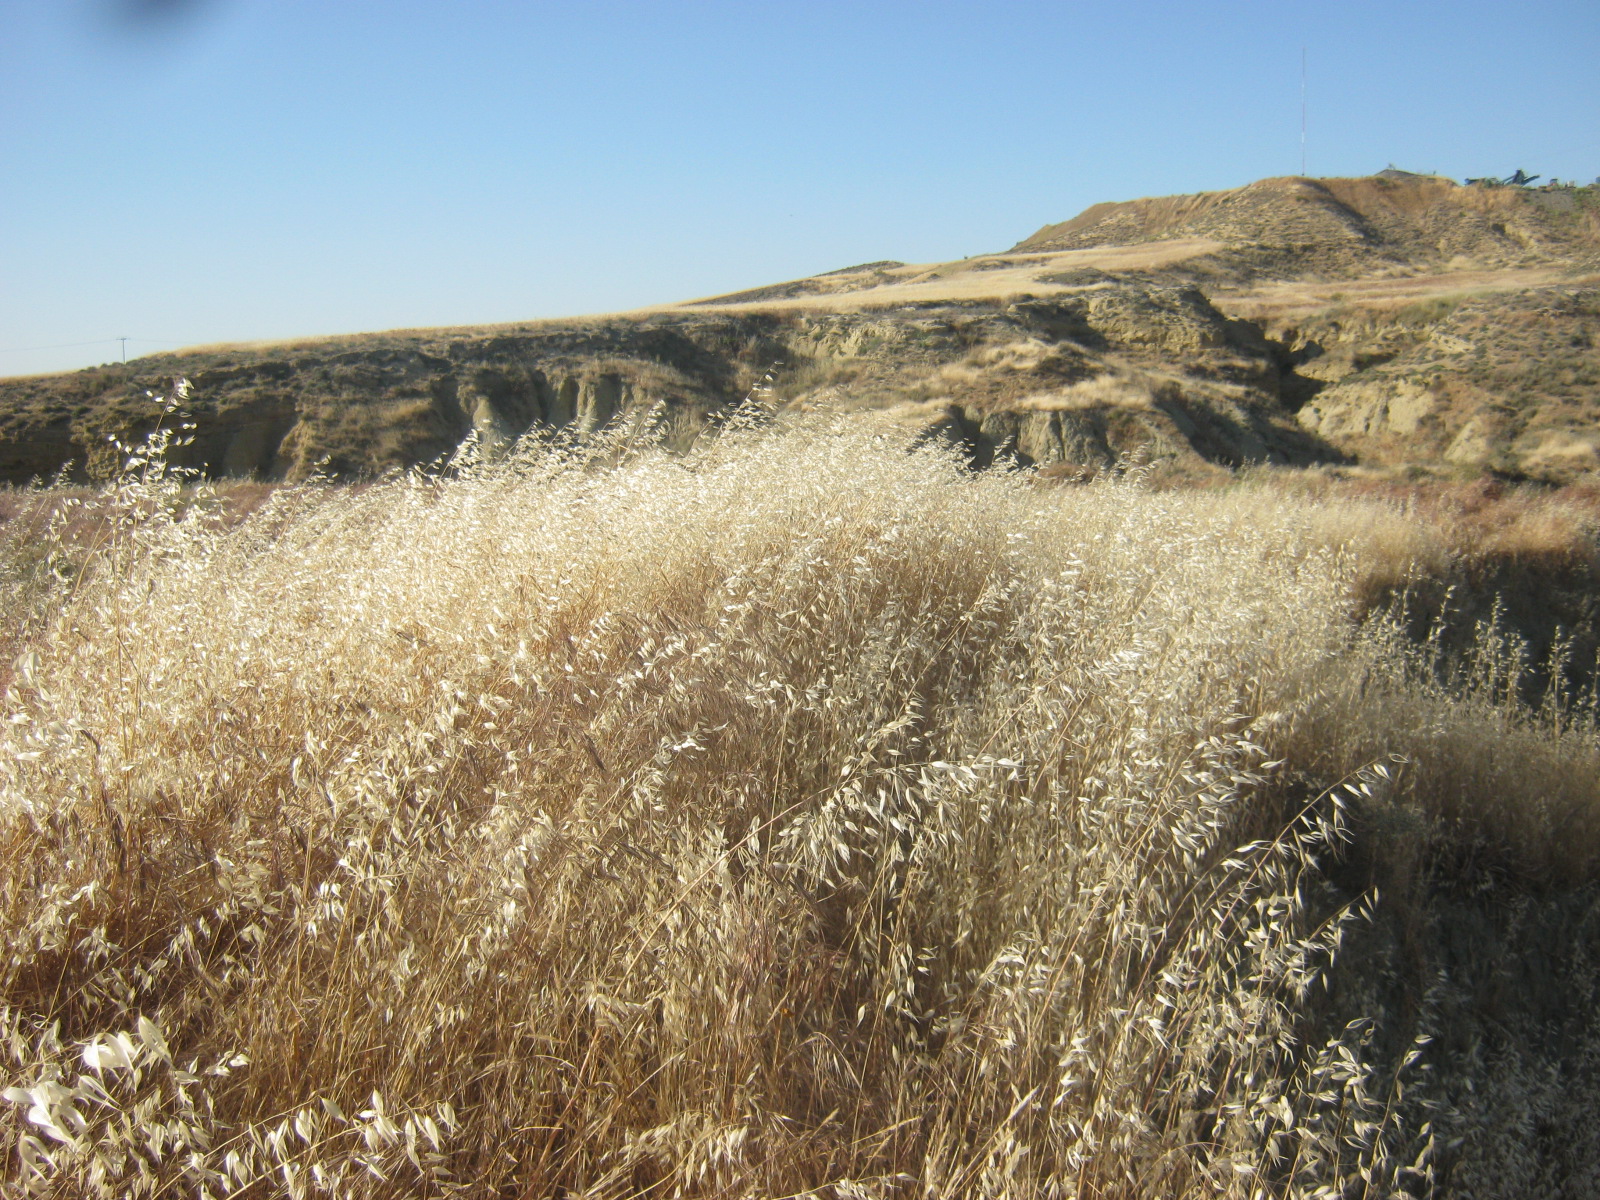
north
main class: Grassland
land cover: Spontaneously vegetated surfaces
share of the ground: > 75 %
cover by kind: herbaceous plants 95 %, unconsolidated bare surface 5 %
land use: Semi-natural and natural areas not in use
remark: Temporary dry
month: May
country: CY
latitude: 35.0563
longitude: 33.2204
